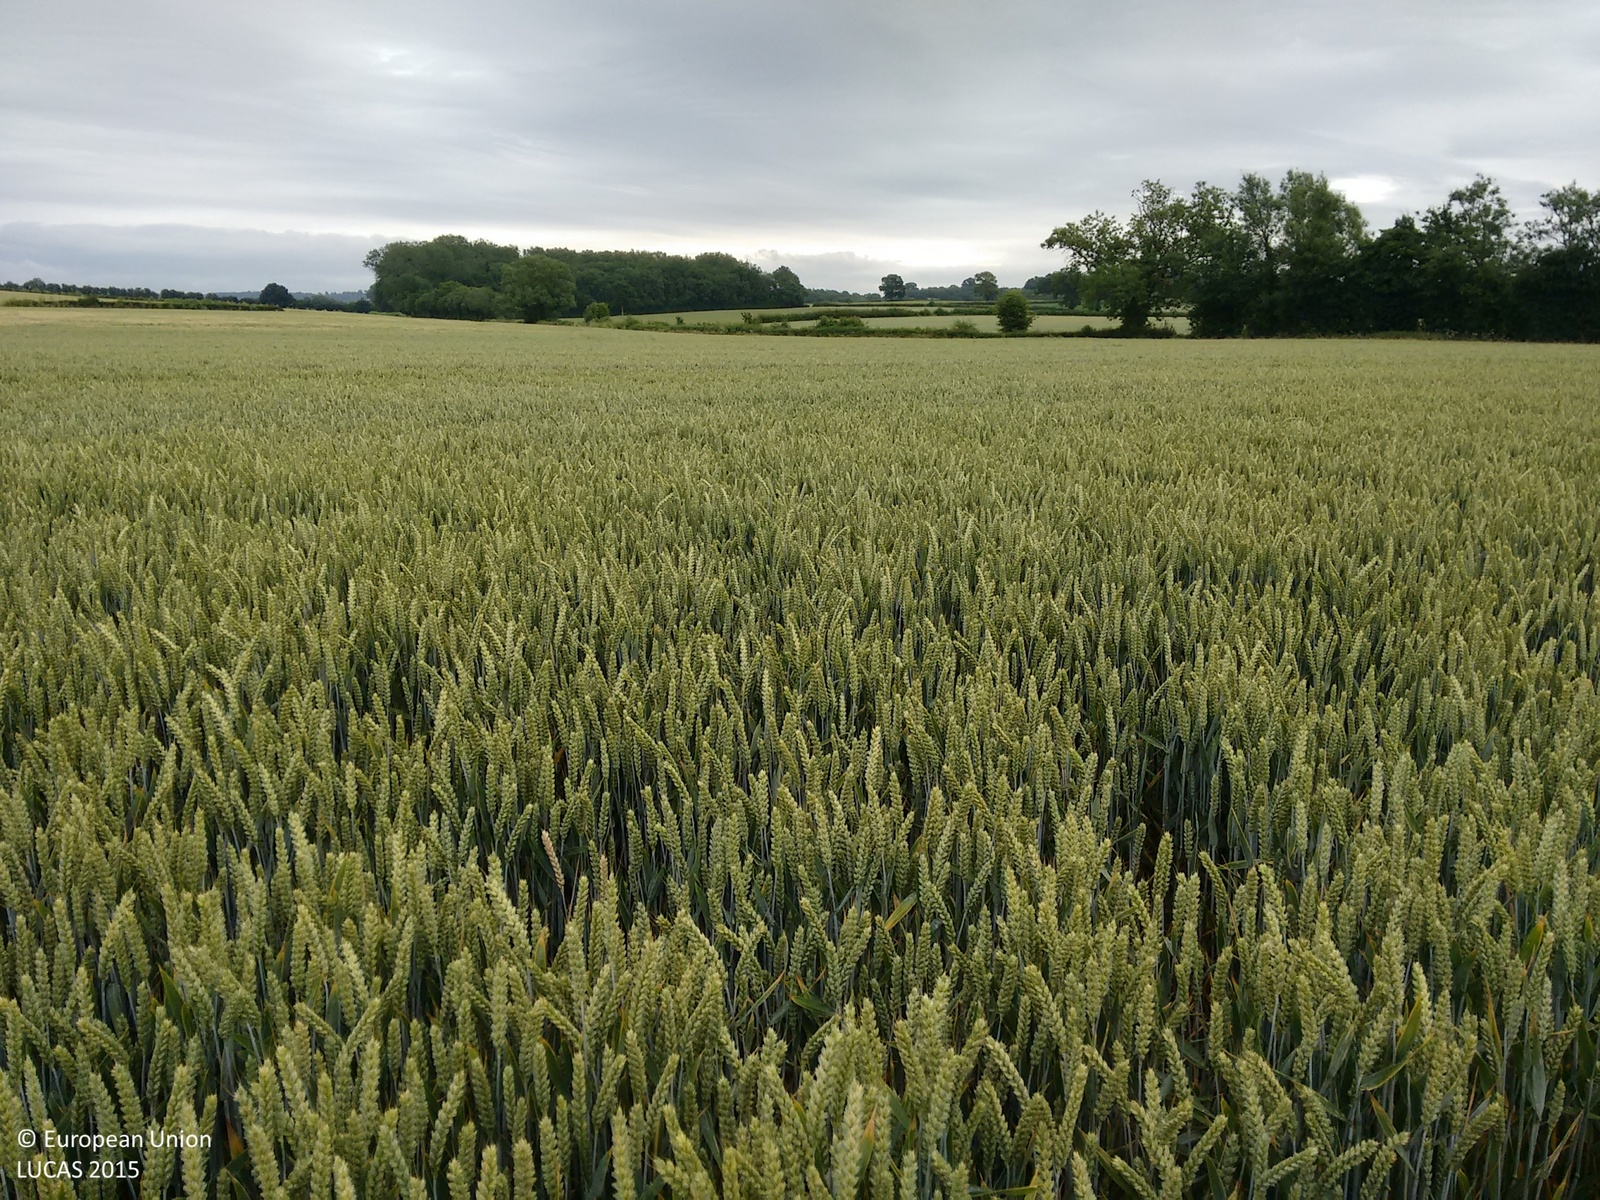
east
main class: Cropland
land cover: Common wheat
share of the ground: > 75 %
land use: Agriculture (excluding fallow land and kitchen gardens)
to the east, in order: Common wheat; Grass margins; Managed hedges; Grass margins; Common wheat
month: July
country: GB
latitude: 52.1085
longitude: -2.5513
